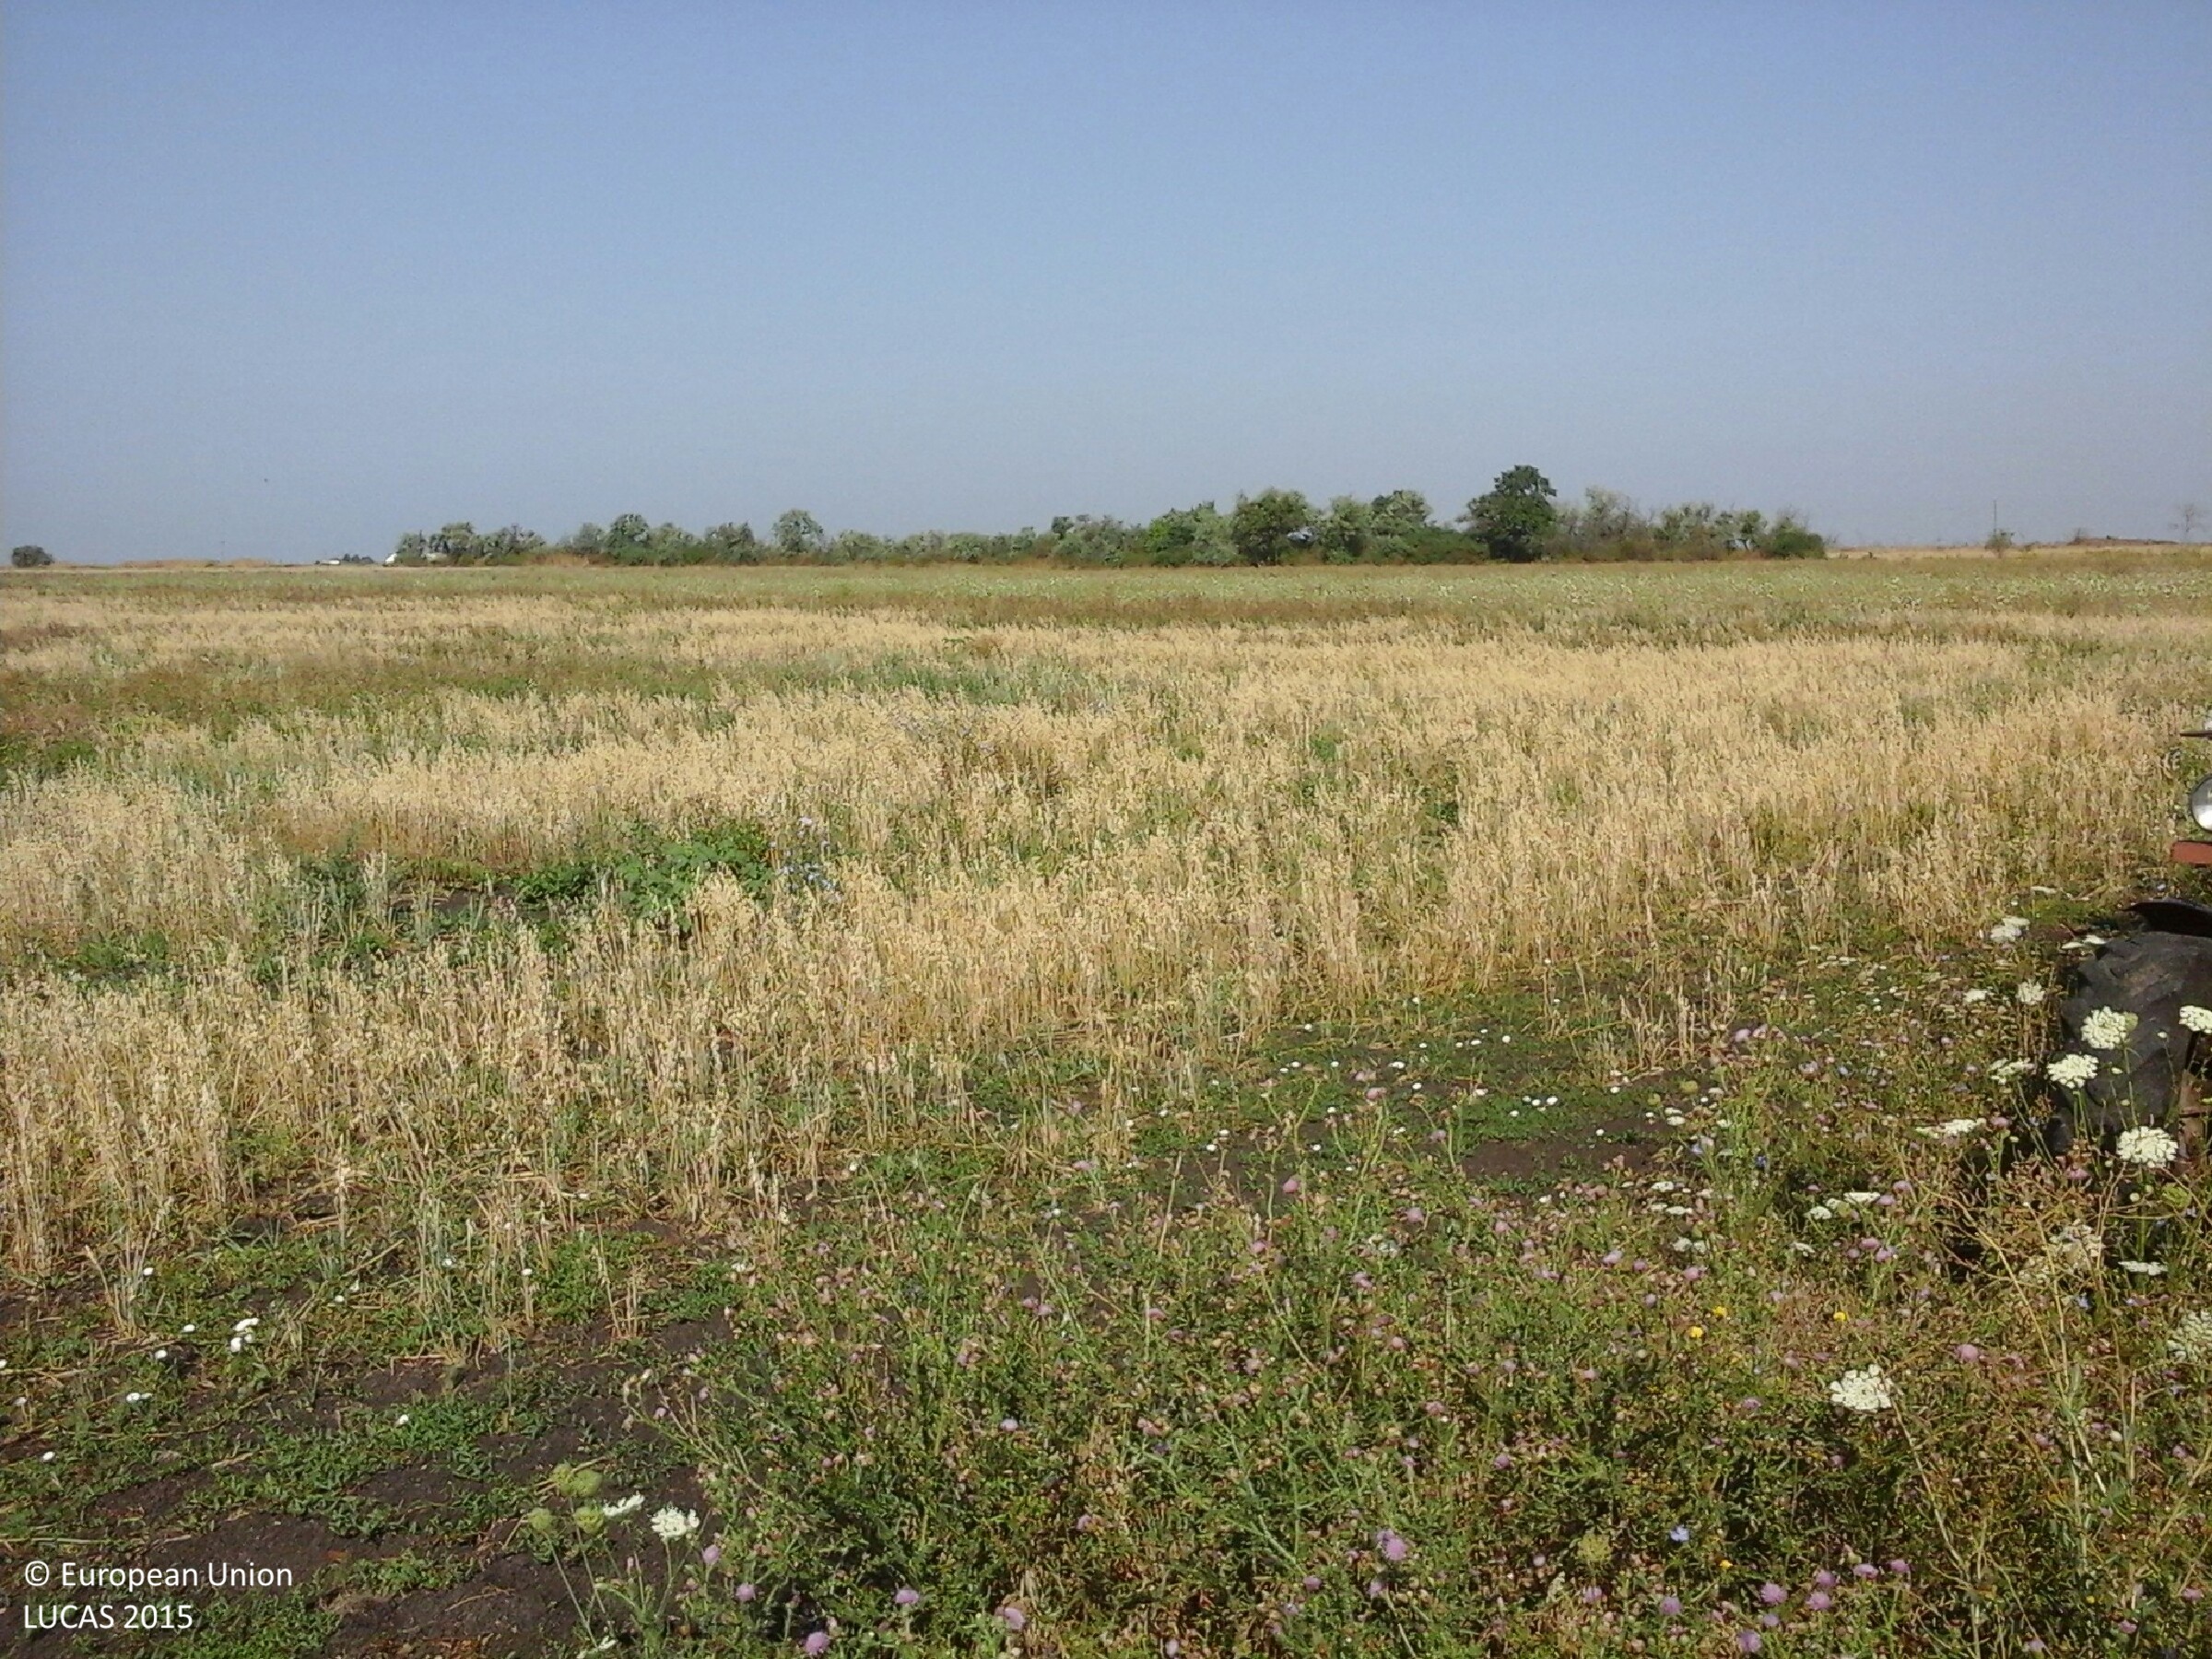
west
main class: Grassland
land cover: Grassland without tree/shrub cover
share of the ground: > 75 %
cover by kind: herbaceous plants 100 %
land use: Agriculture (excluding fallow land and kitchen gardens)
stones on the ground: < 10 %
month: August
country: HU
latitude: 47.2217
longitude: 20.9560
